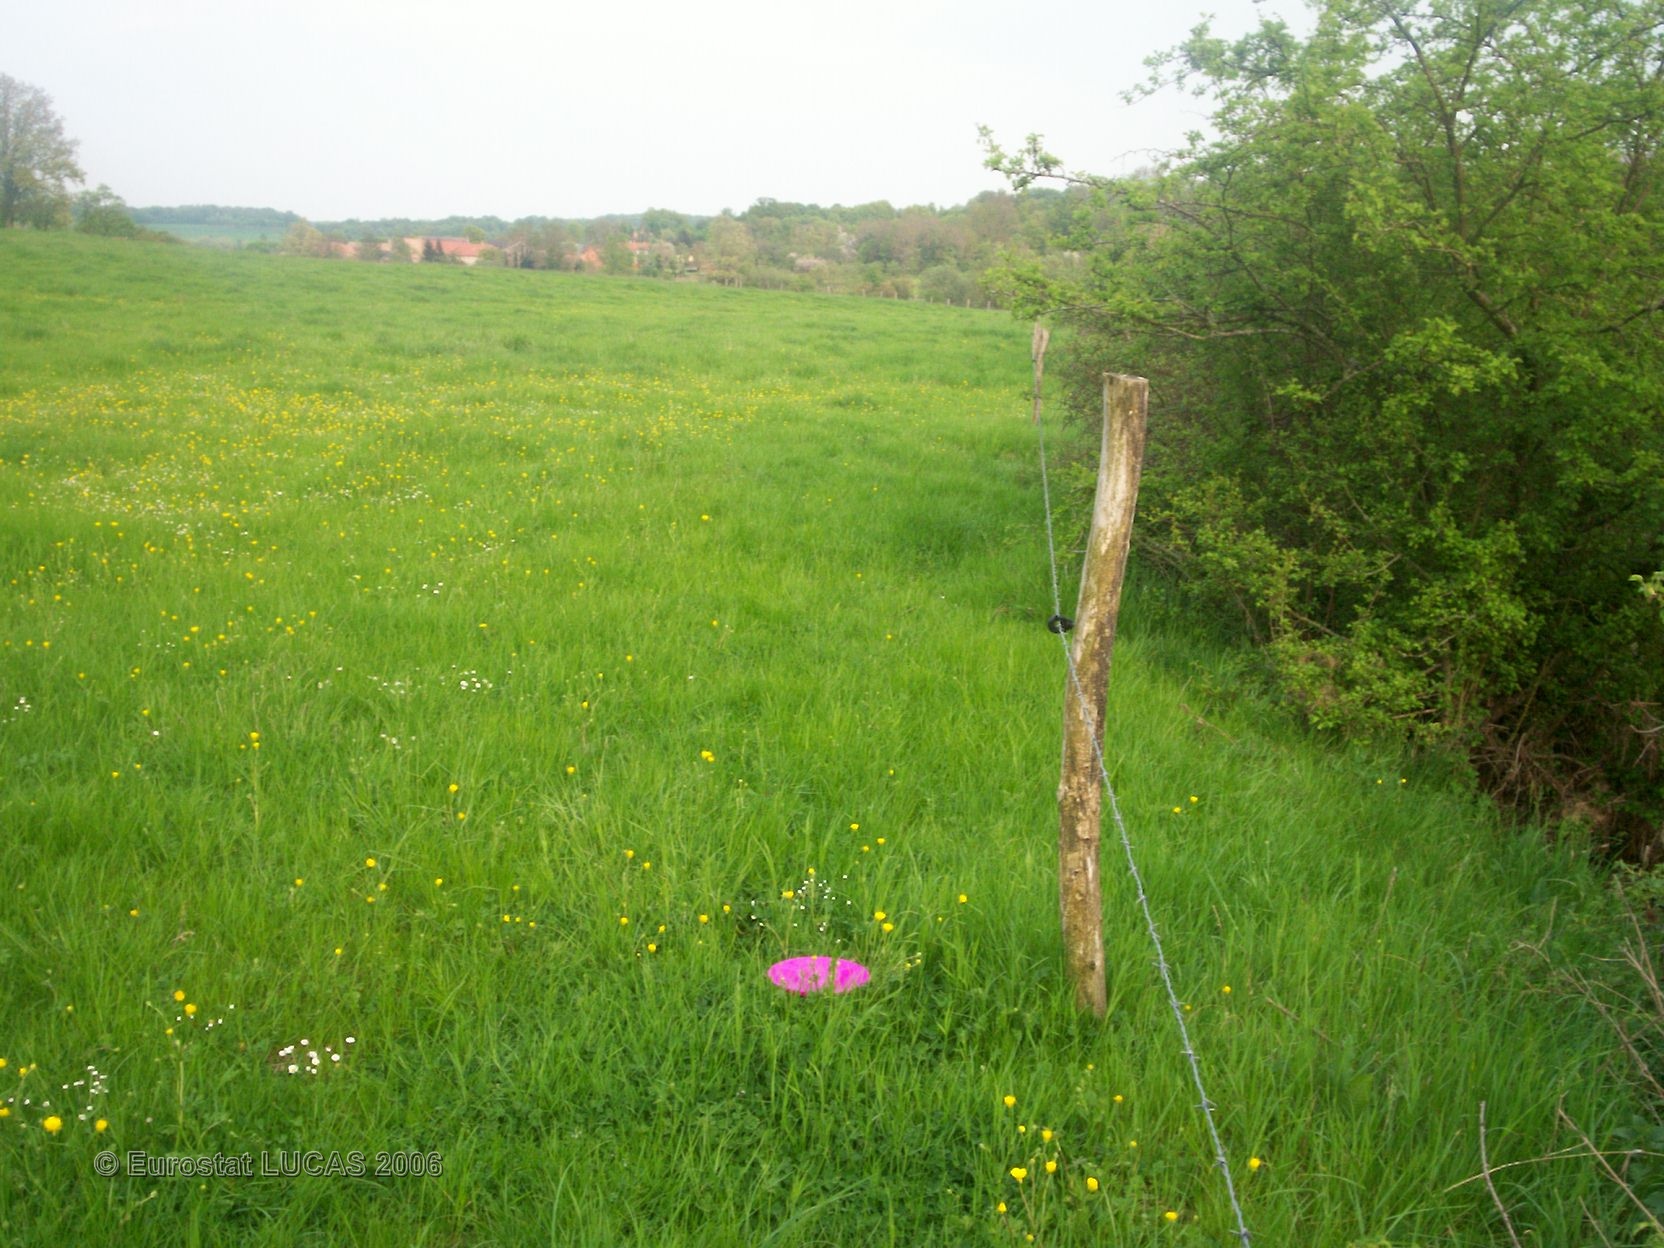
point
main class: Grassland
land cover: Grassland without tree/shrub cover
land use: Agriculture (excluding fallow land and kitchen gardens)
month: May
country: FR
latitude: 48.7588
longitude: 6.9943
